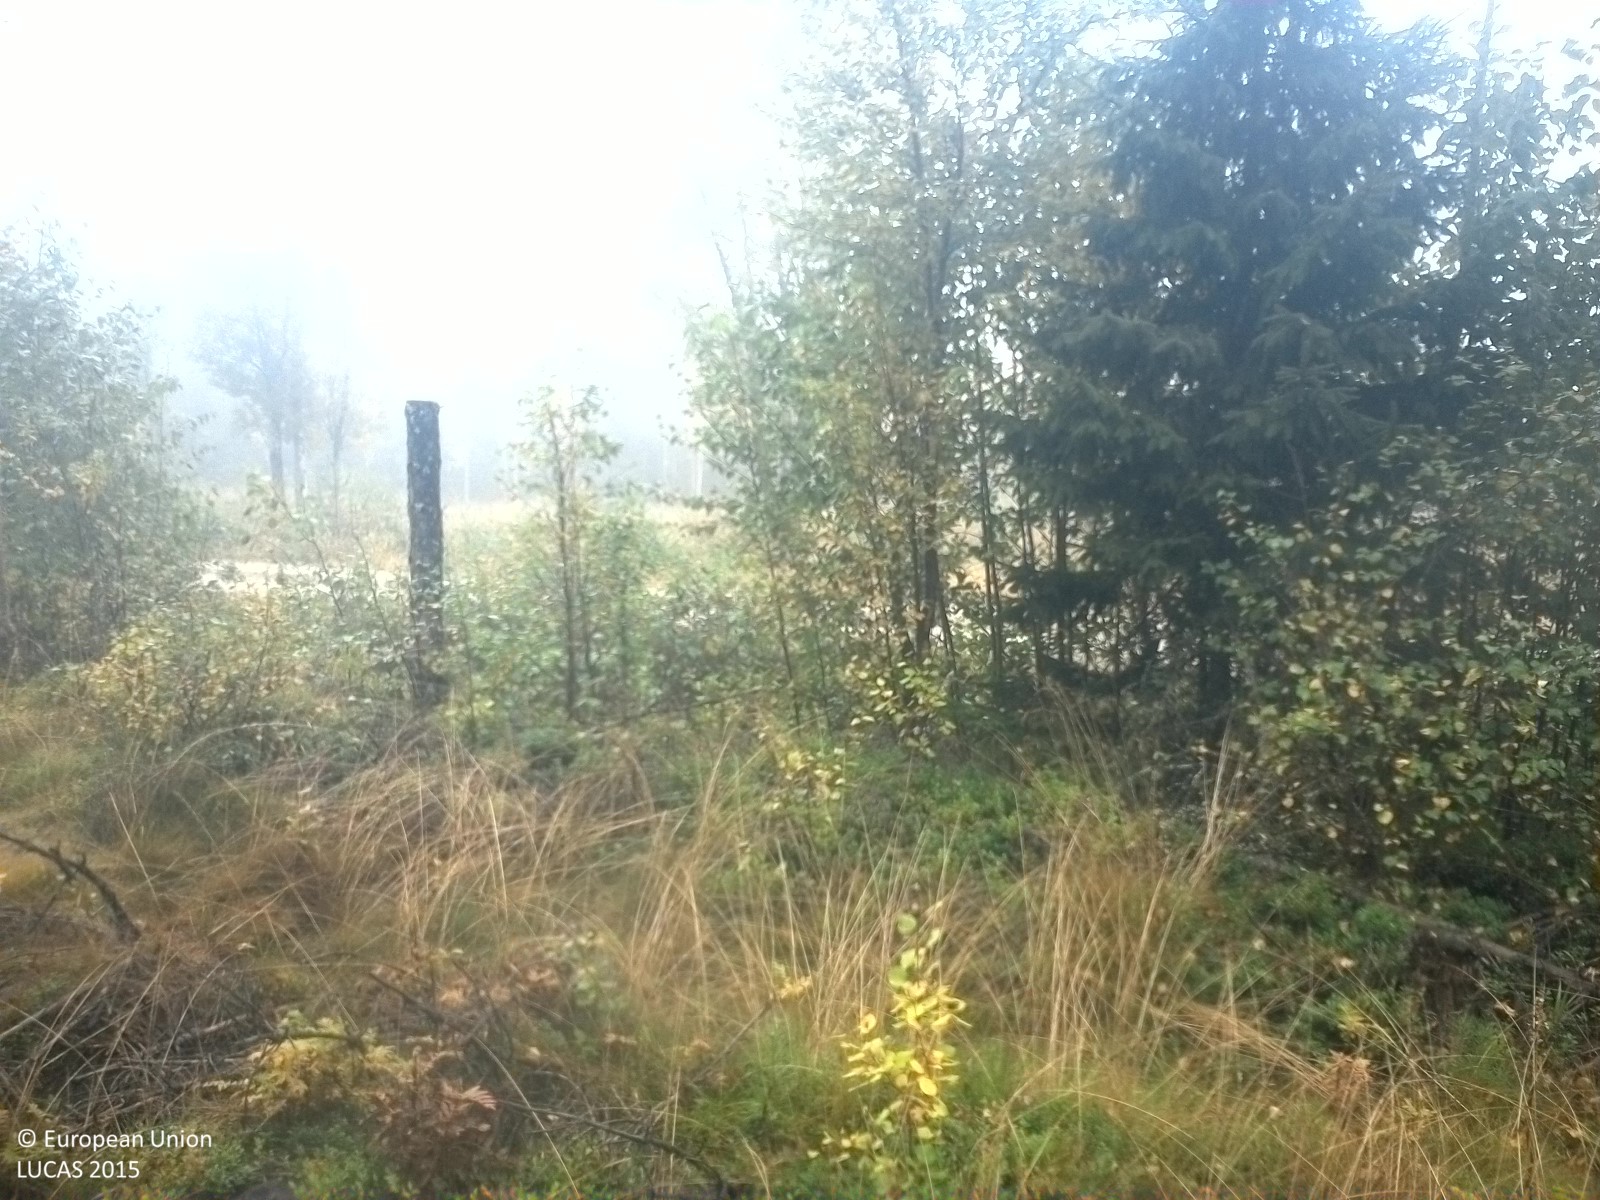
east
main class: Woodland
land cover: Other coniferous woodland
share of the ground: 50 - 75 %
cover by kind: coniferous forest trees 45 %, shrubs 30 %, herbaceous plants 10 %, lichens and mosses 10 %, broadleaved forest trees 5 %
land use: Forestry
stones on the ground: < 10 %
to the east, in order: Other coniferous woodland; Broadleaved woodland; Ditches and canals; Paved roads, cycling and walking lanes; Grass margins; Pine dominated mixed woodland; Spruce dominated coniferous woodland; Other mixed woodland; Pine dominated mixed woodland
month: September
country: SE
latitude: 62.0001
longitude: 15.6526
